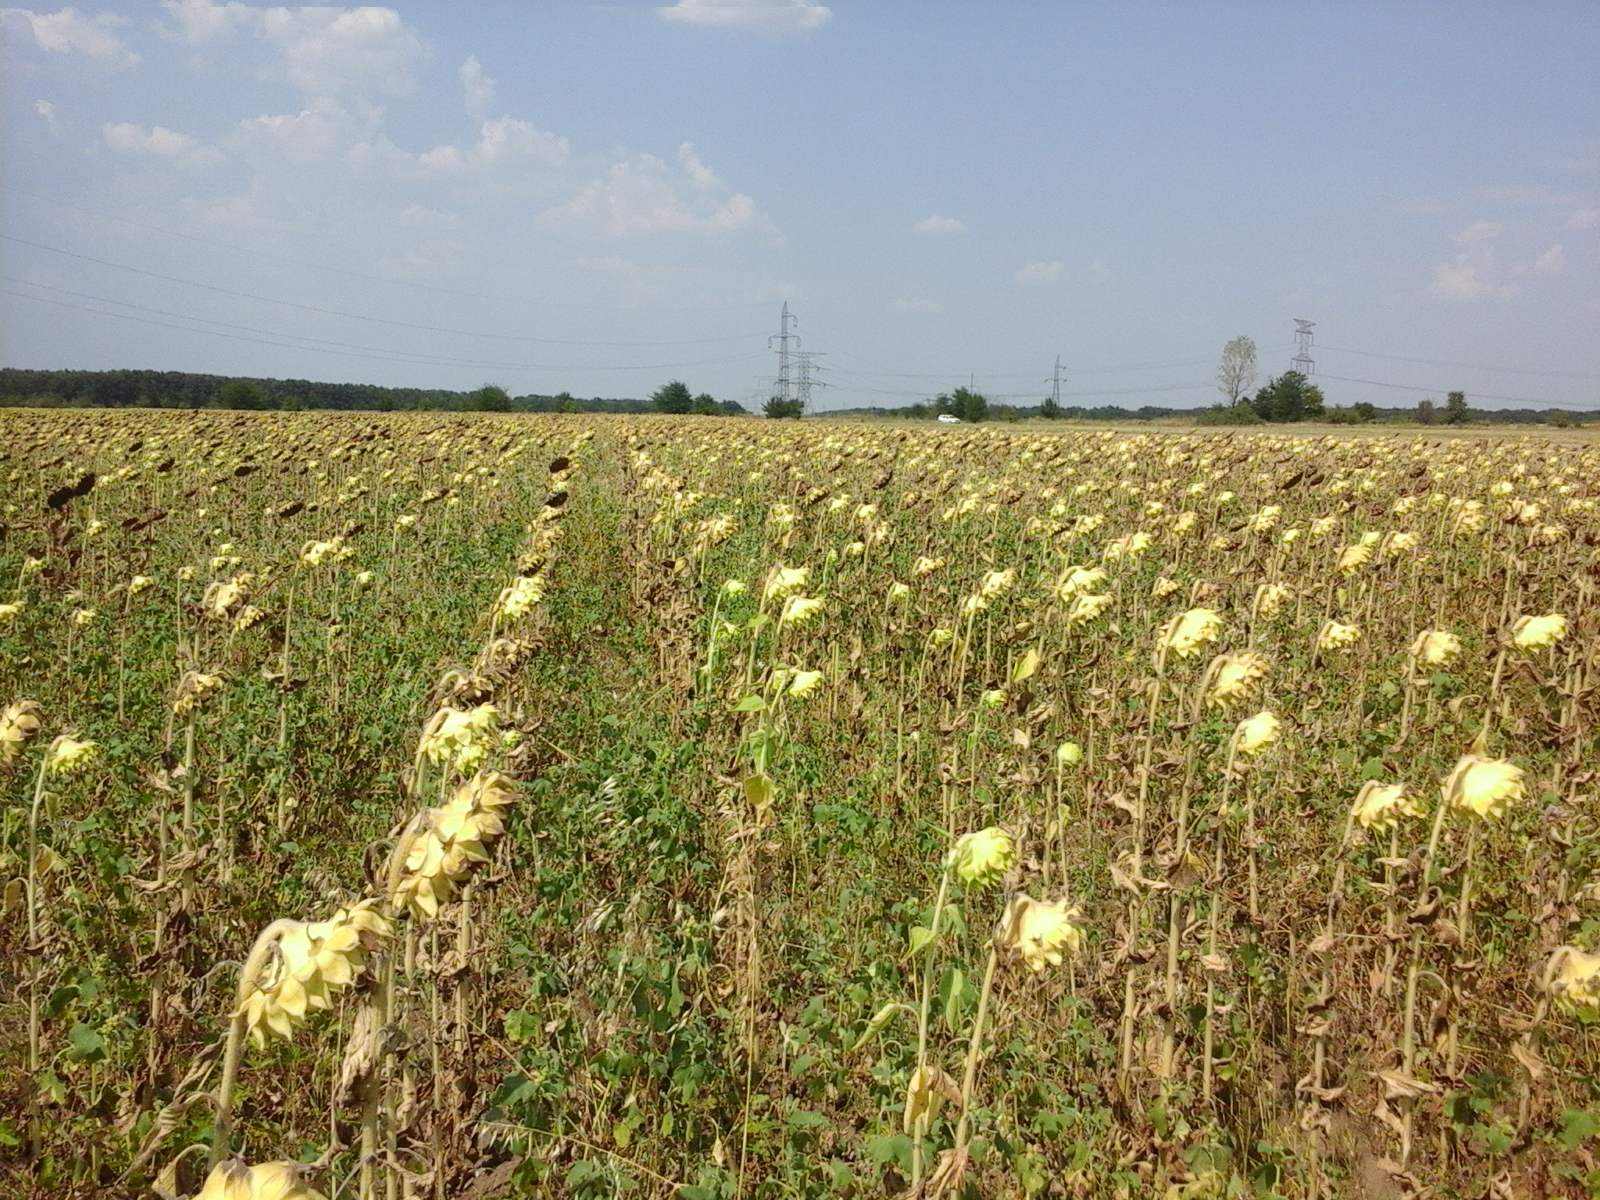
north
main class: Cropland
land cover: Sunflower
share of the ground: 50 - 75 %
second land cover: Spontaneously vegetated surfaces
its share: 25 - 50 %
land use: Agriculture (excluding fallow land and kitchen gardens)
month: August
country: RO
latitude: 44.1733
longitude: 23.5213
